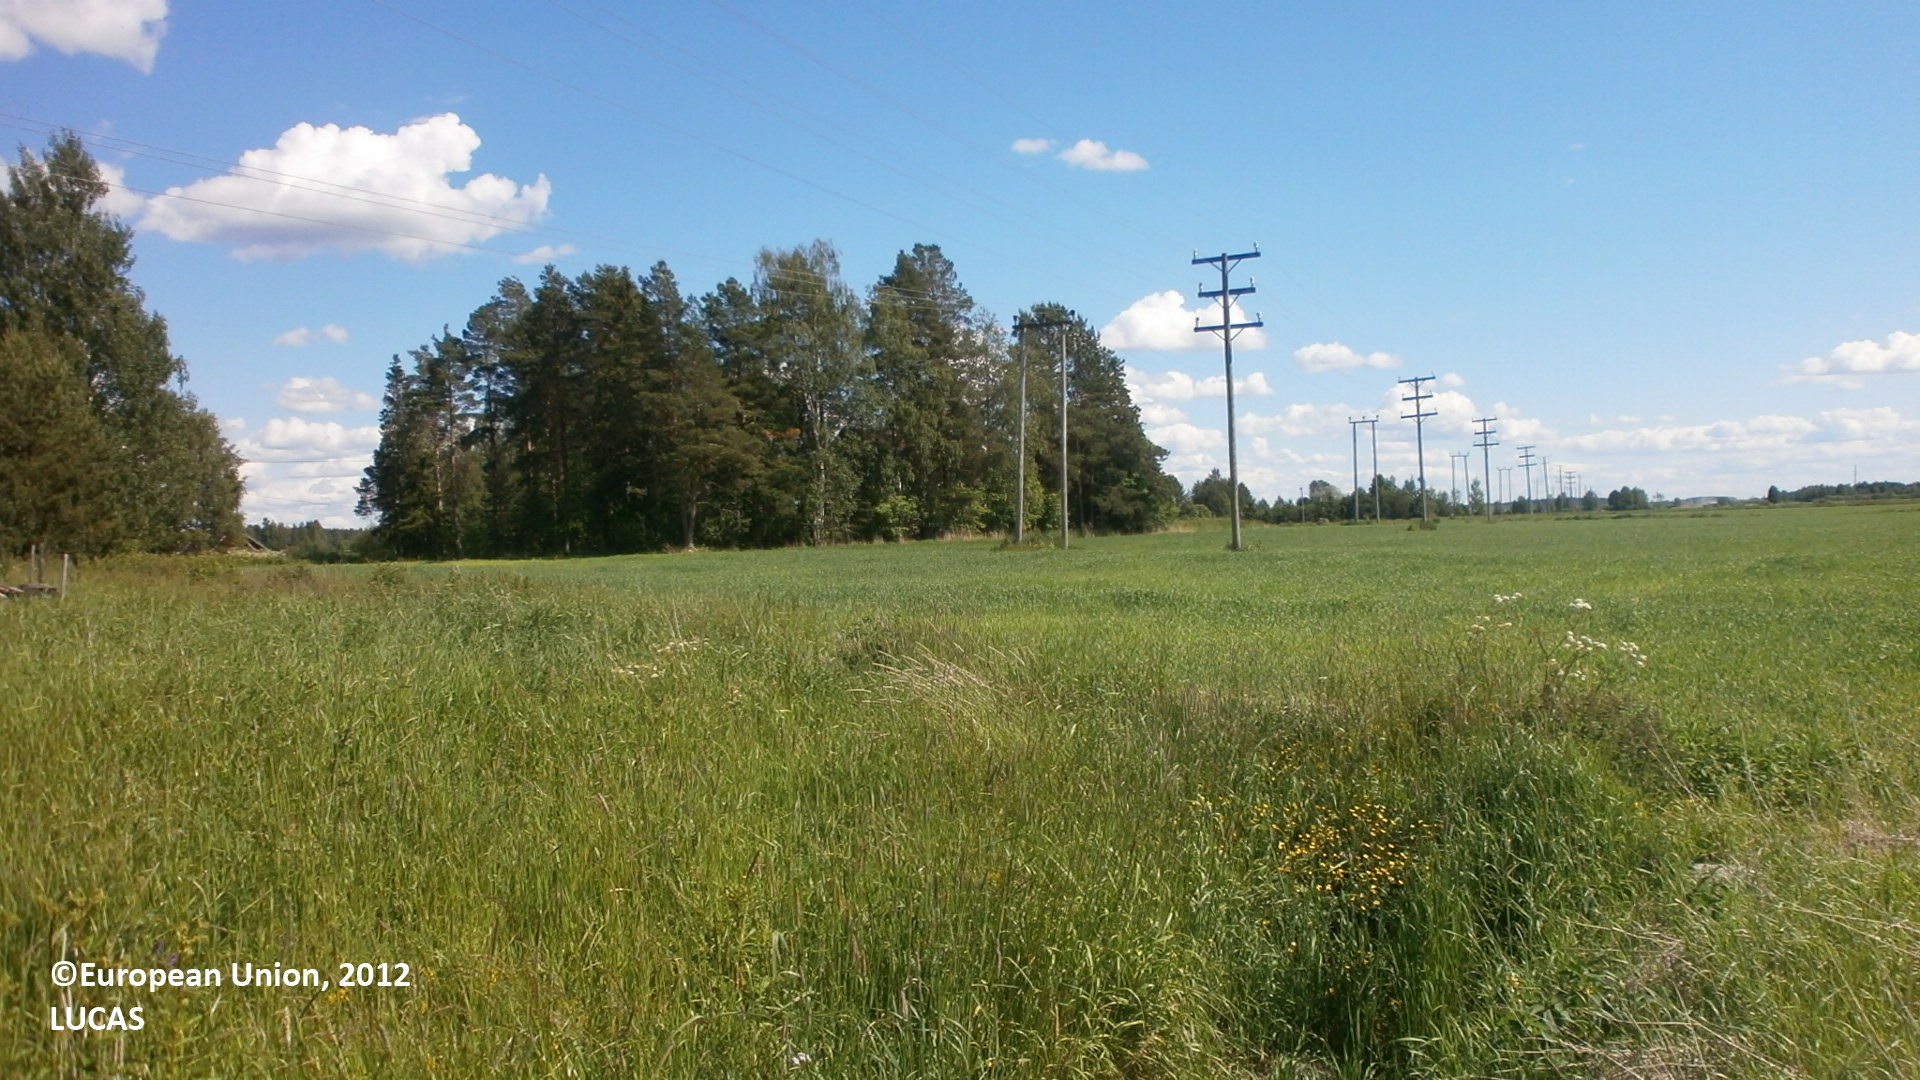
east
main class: Cropland
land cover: Barley
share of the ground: 25 - 50 %
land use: Agriculture (excluding fallow land and kitchen gardens)
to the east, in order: Barley; Electric lines; Barley; Electric lines; Barley; Grass margins; Ditches and canals; Pine dominated mixed woodland; Spontaneously vegetated surfaces; Pine dominated mixed woodland; Ditches and canals; Shruby margins; Tracks; Shruby margins; Ditches and canals; Shruby margins; Barley; Electric lines; Barley
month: July
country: FI
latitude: 63.9959
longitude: 24.7787
